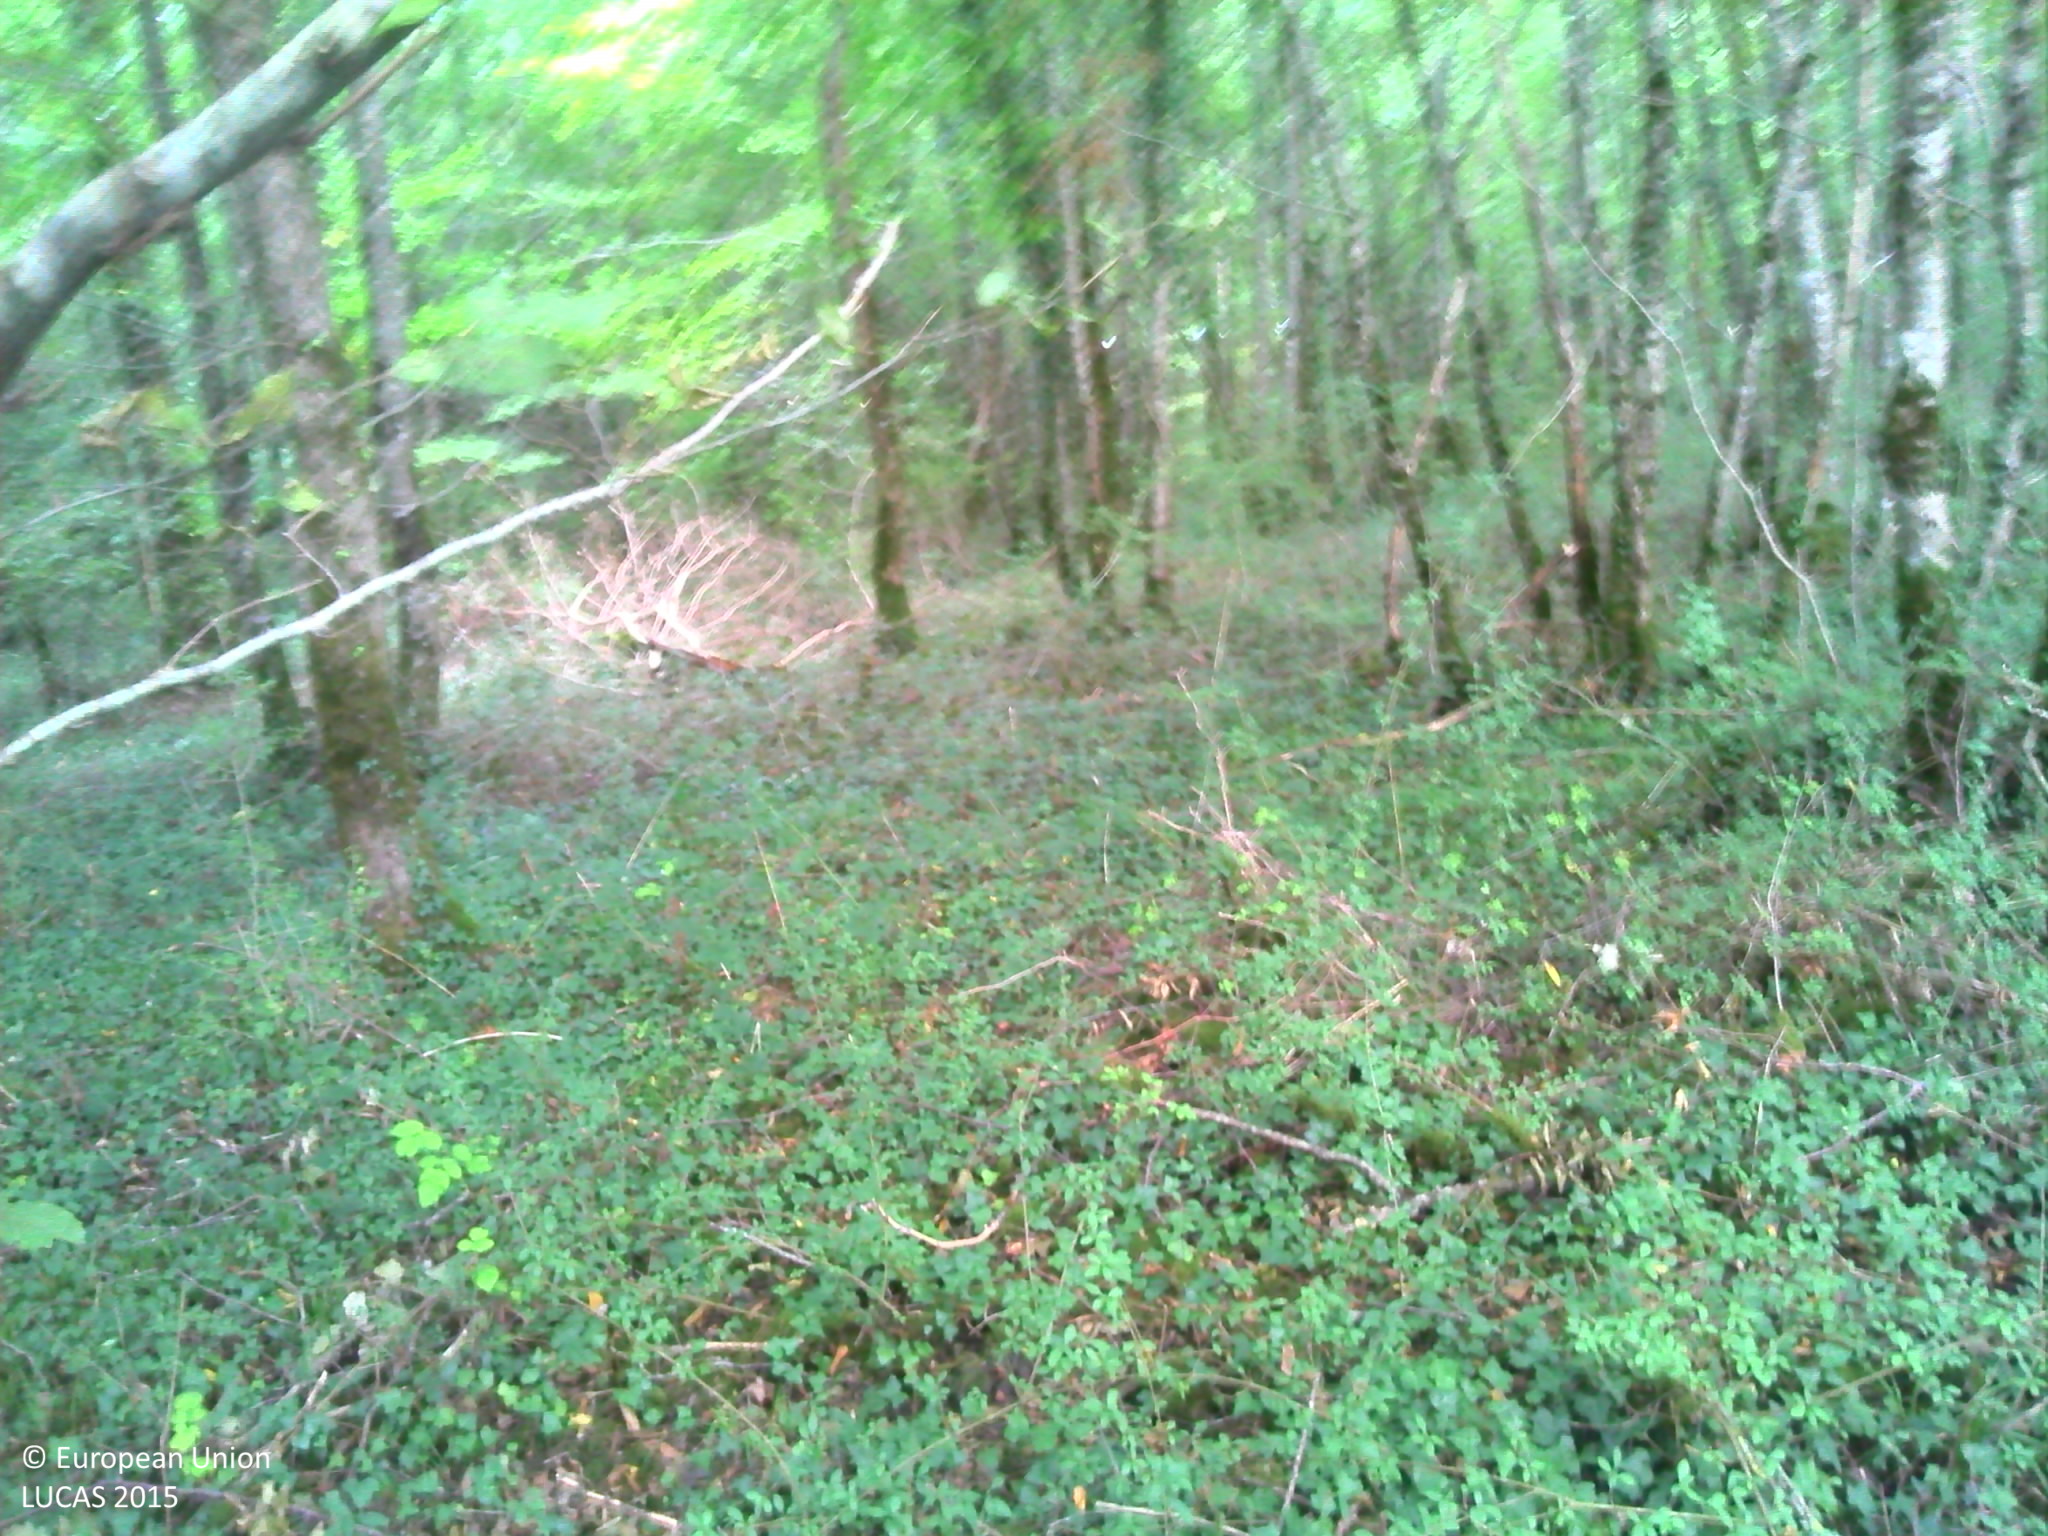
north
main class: Woodland
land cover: Broadleaved woodland
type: mesophytic deciduous forest
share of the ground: > 75 %
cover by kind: broadleaved forest trees 95 %, herbaceous plants 5 %
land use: Forestry
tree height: > 5 m
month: September
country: FR
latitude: 46.7781
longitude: 1.5677
